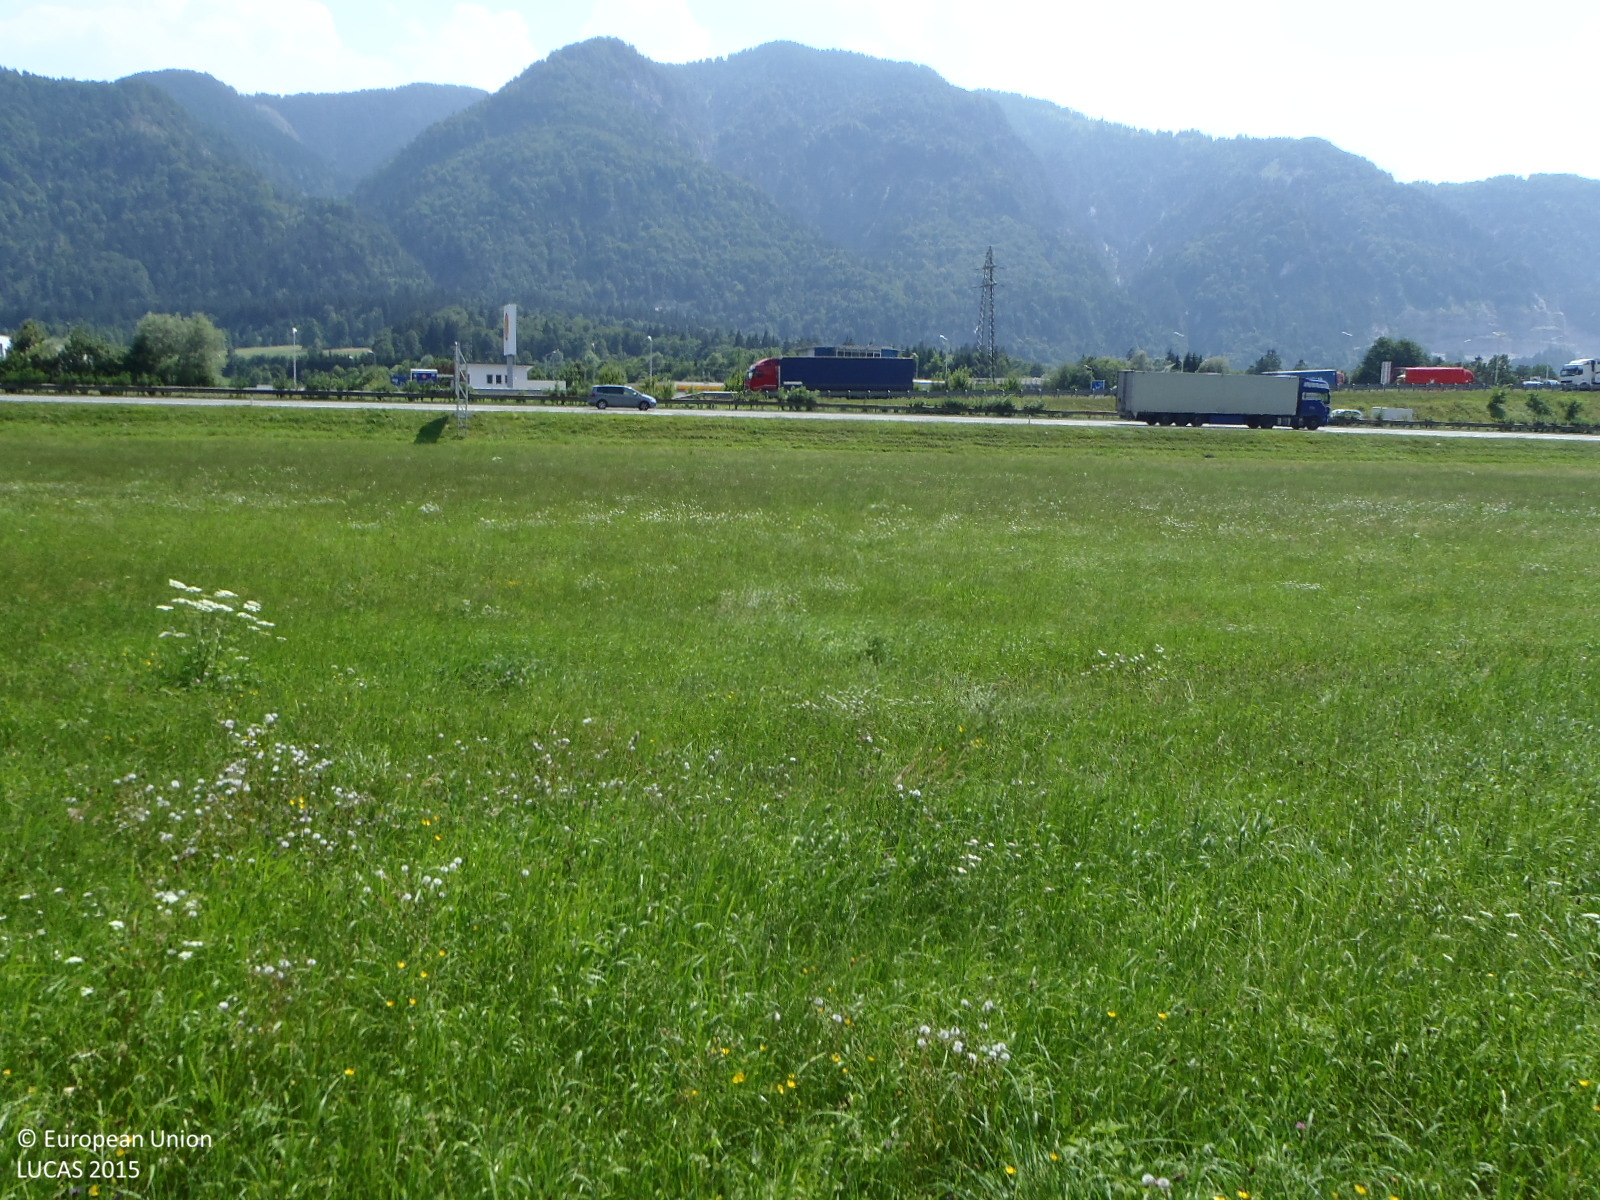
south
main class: Grassland
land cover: Grassland without tree/shrub cover
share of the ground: > 75 %
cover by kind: herbaceous plants 100 %
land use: Agriculture (excluding fallow land and kitchen gardens)
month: July
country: AT
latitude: 47.4847
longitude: 12.0290
